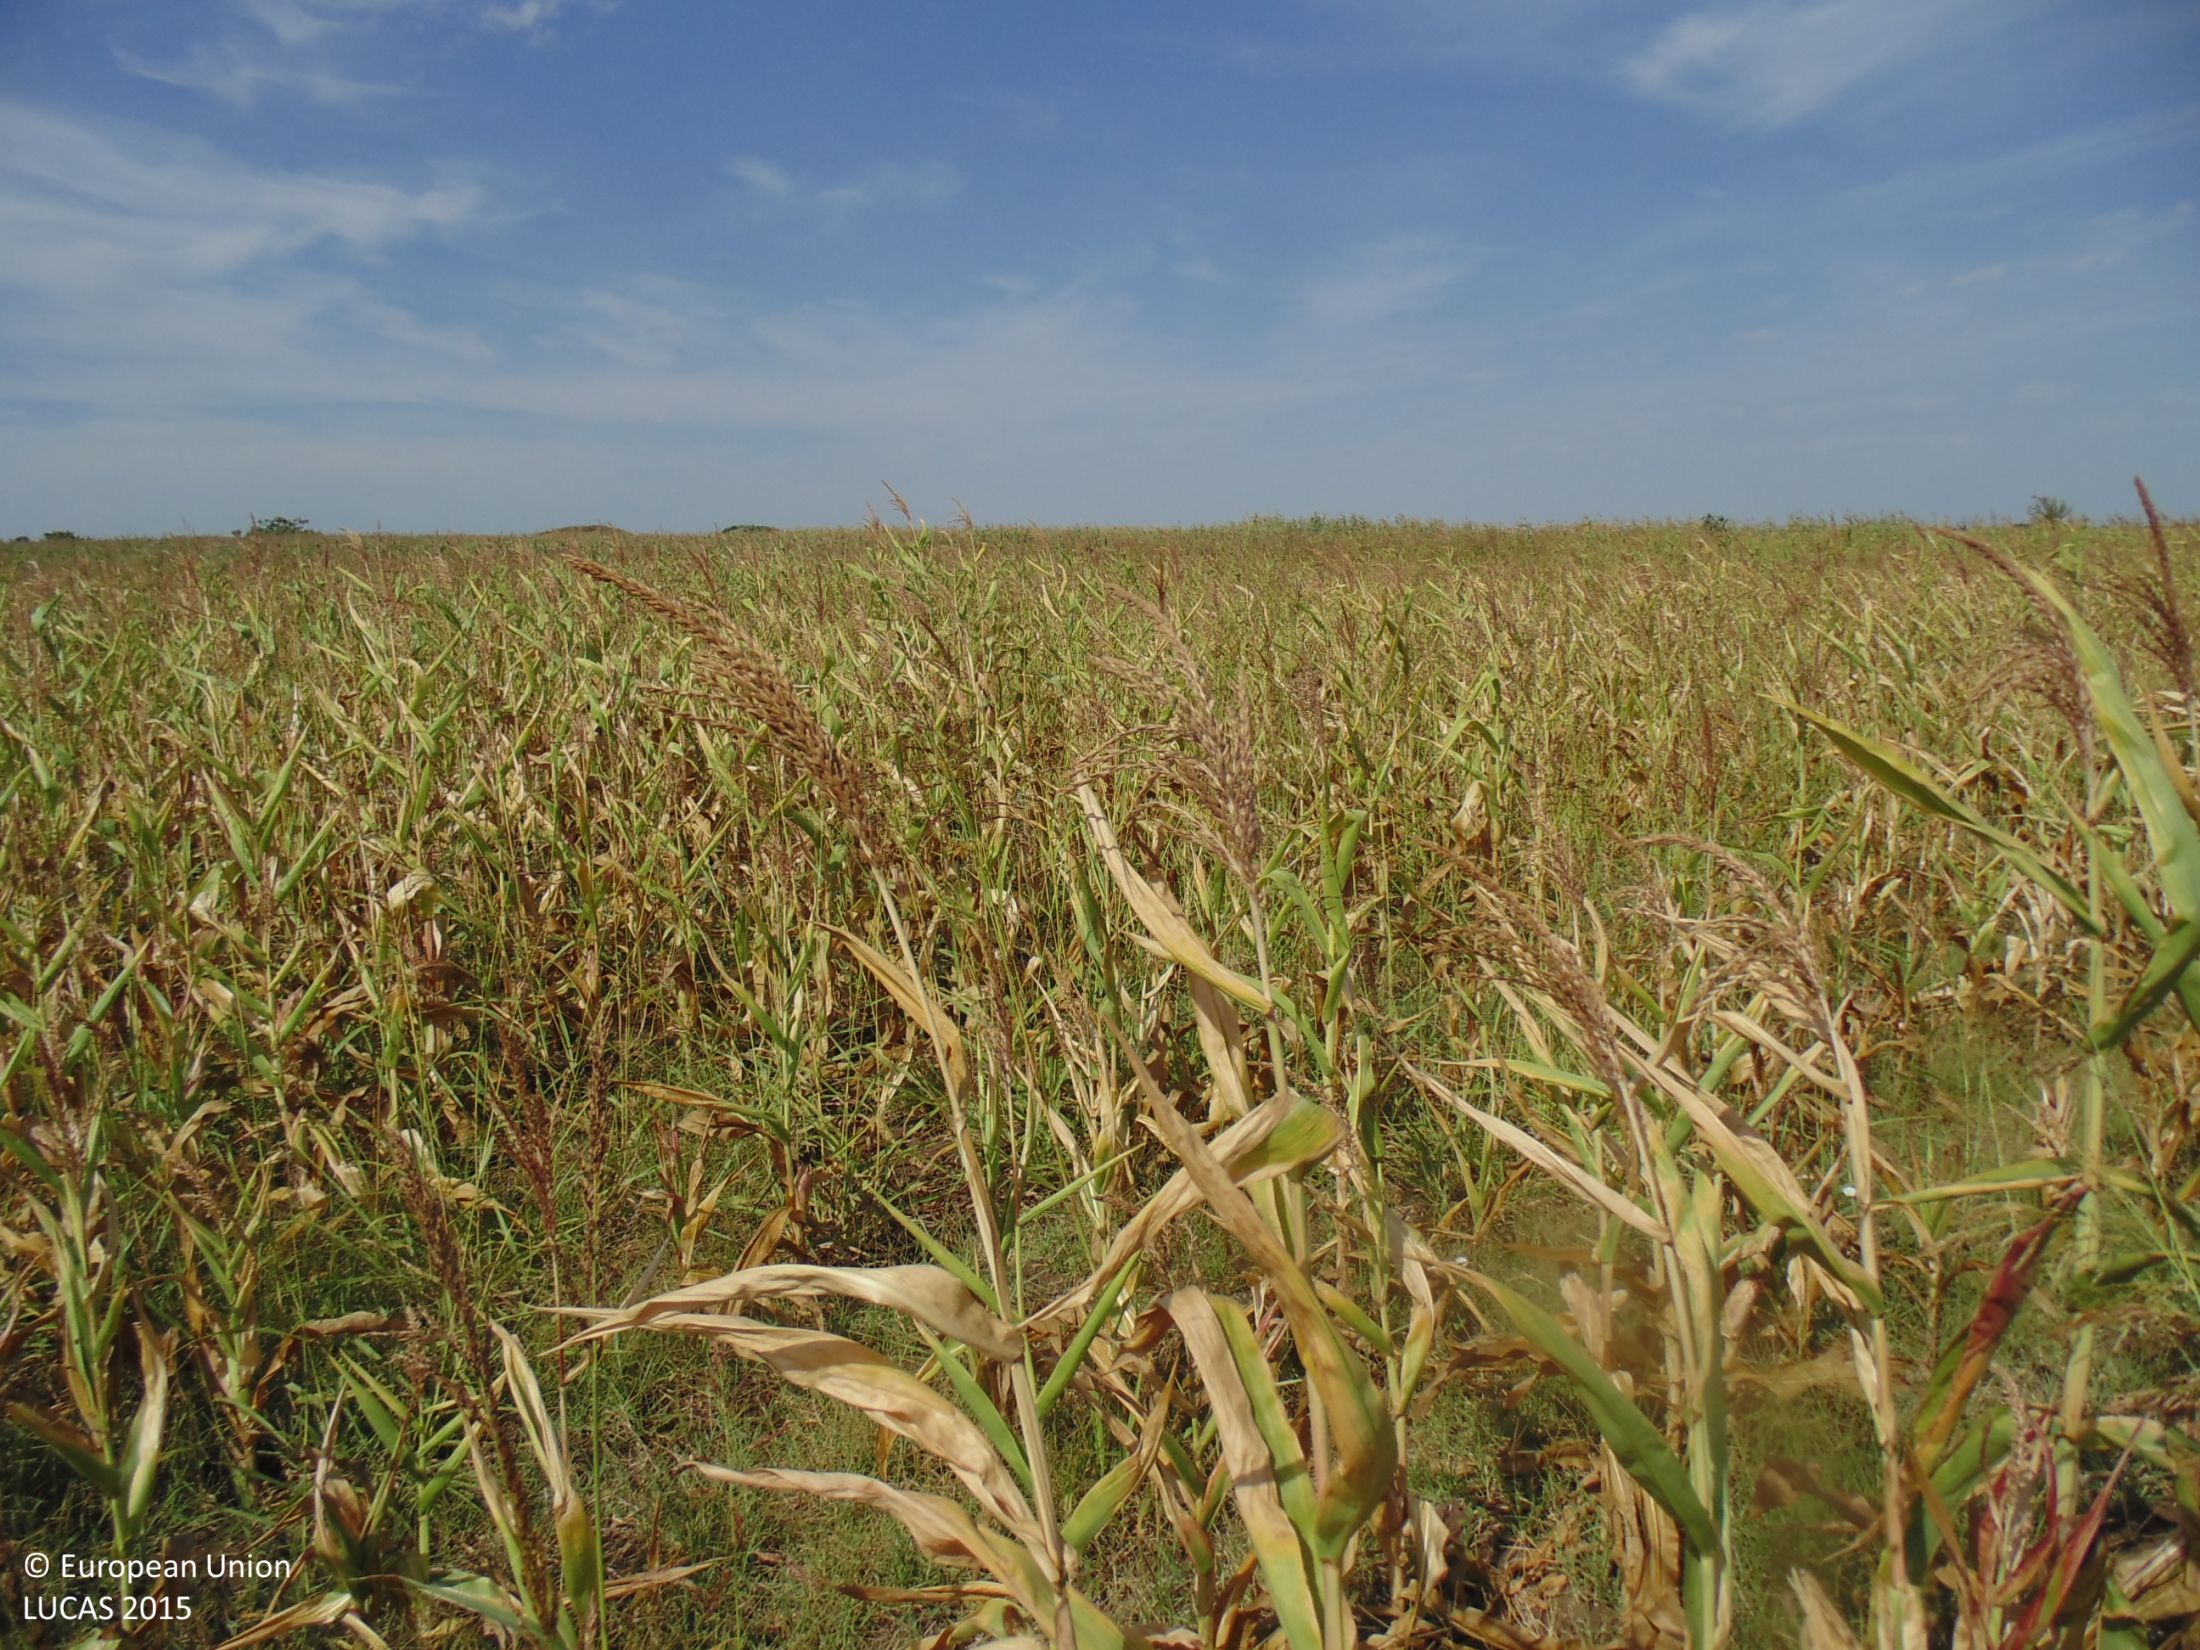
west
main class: Cropland
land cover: Maize
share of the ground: > 75 %
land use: Agriculture (excluding fallow land and kitchen gardens)
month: August
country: BG
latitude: 43.7222
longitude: 28.4980
